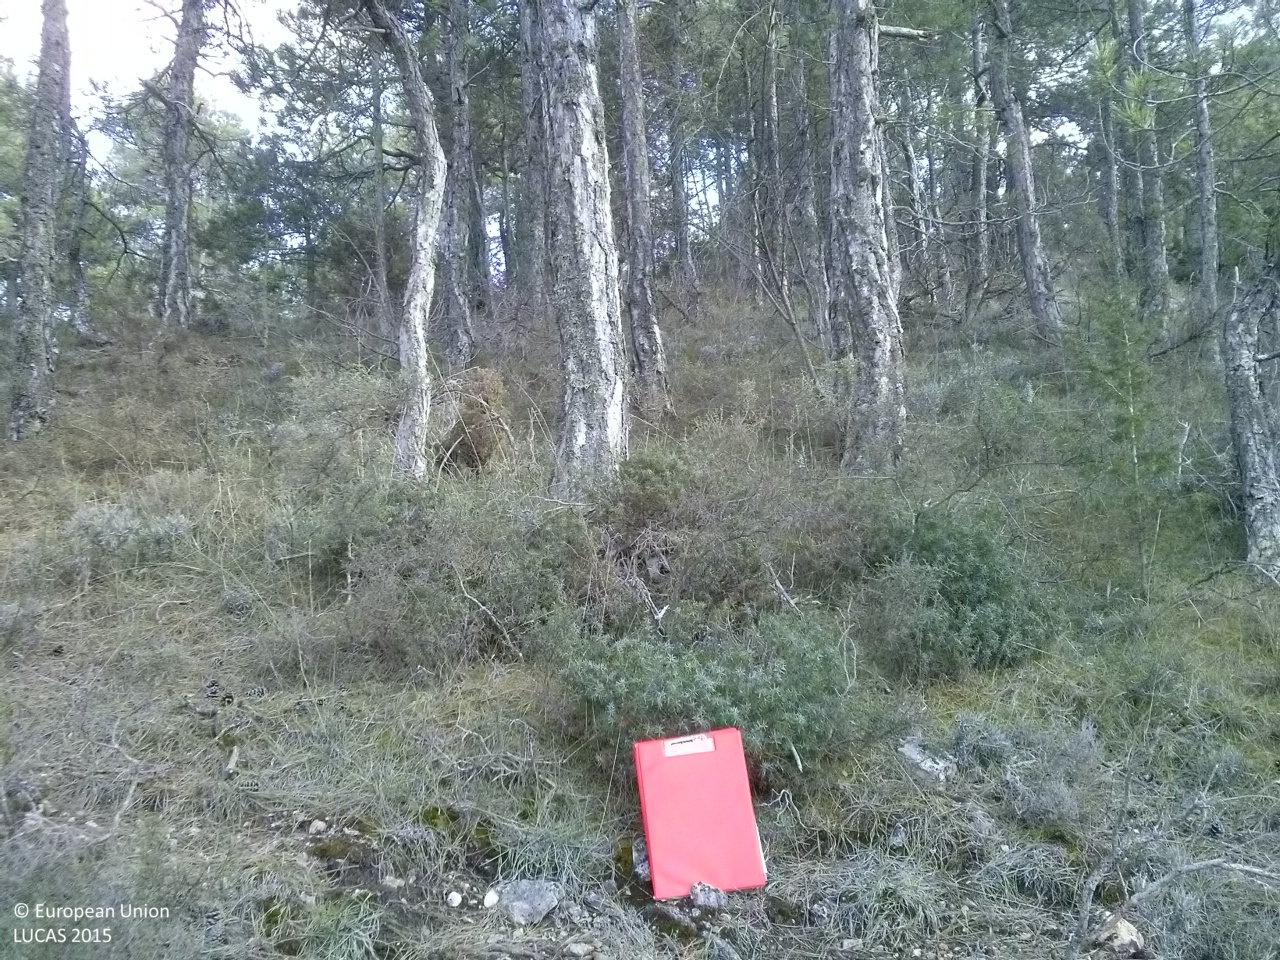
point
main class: Woodland
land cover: Pine dominated coniferous woodland
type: coniferous forest of the mediterranean region
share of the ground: 50 - 75 %
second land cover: Grassland without tree/shrub cover
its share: 50 - 75 %
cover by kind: coniferous forest trees 50 %, herbaceous plants 30 %, unconsolidated bare surface 15 %, shrubs 5 %
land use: Forestry
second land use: Agriculture (excluding fallow land and kitchen gardens)
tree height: > 5 m
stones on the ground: 10 - 25 %
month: April
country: ES
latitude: 40.1114
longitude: -1.7098
